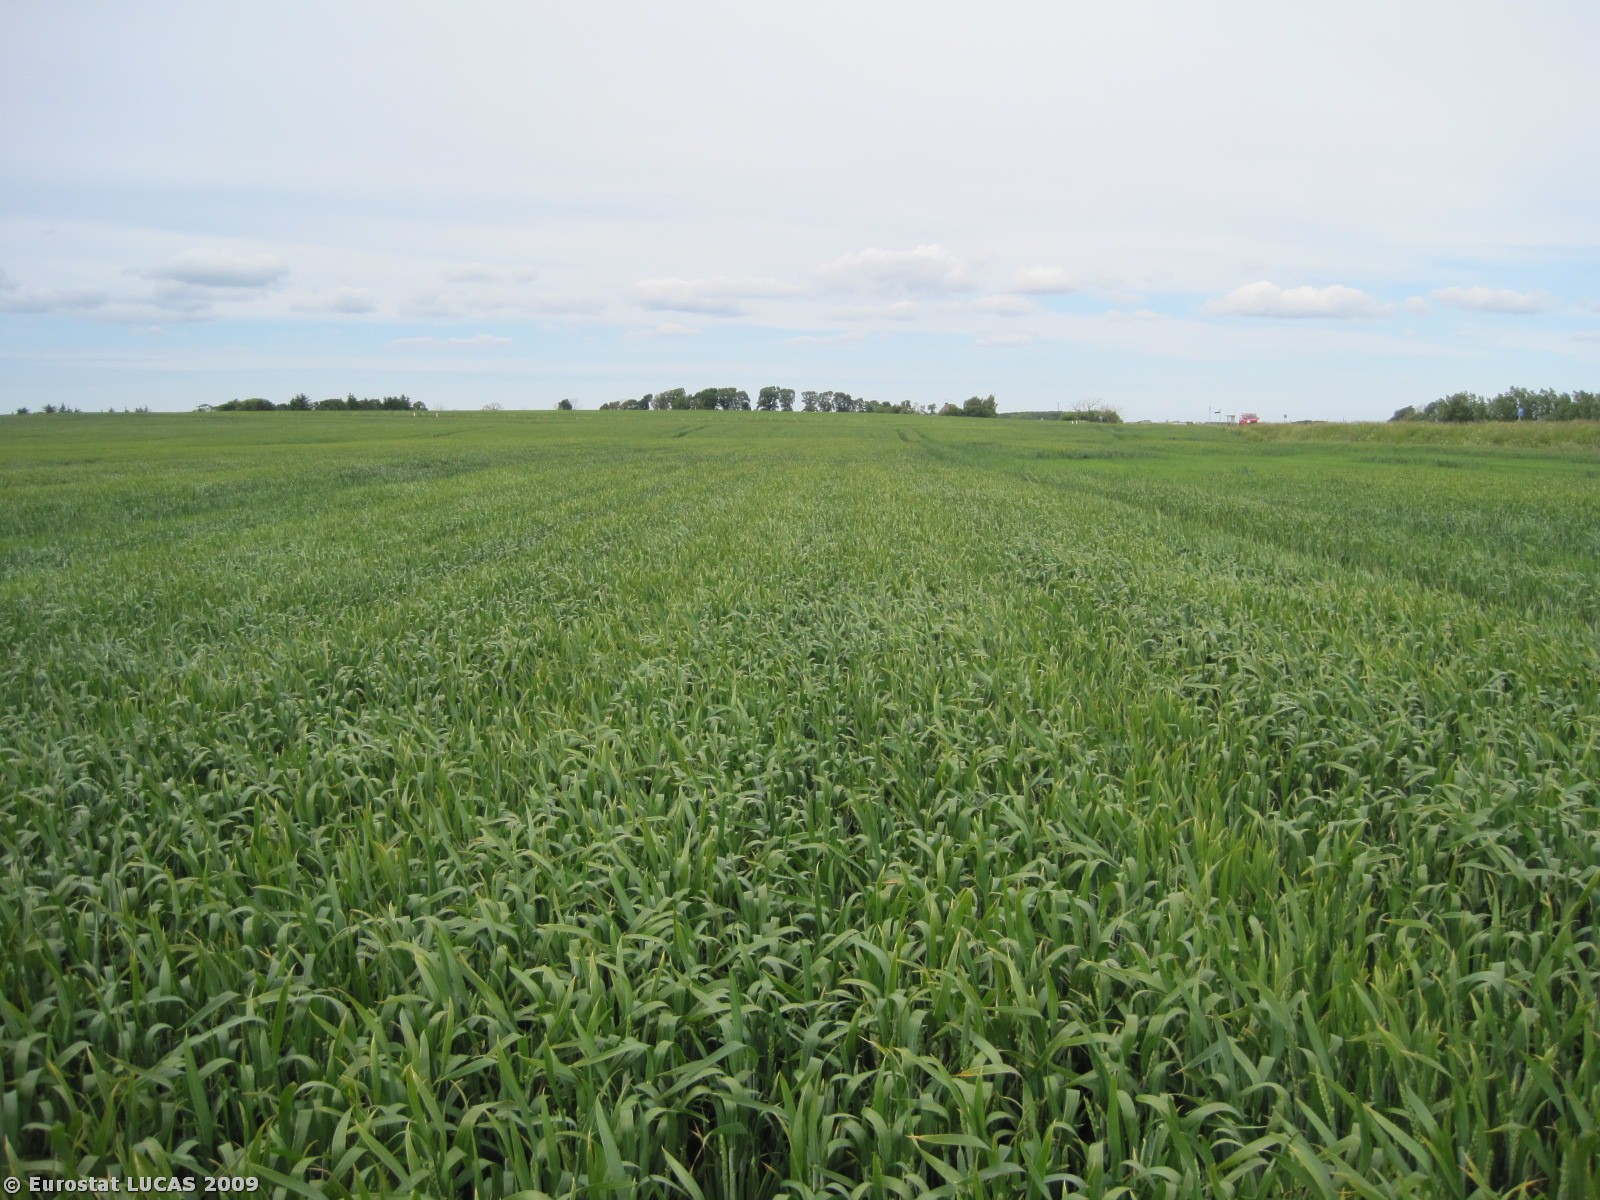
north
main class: Cropland
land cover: Common wheat
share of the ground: > 75 %
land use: Agriculture (excluding fallow land and kitchen gardens)
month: June
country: DK
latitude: 57.3743
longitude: 9.9834
